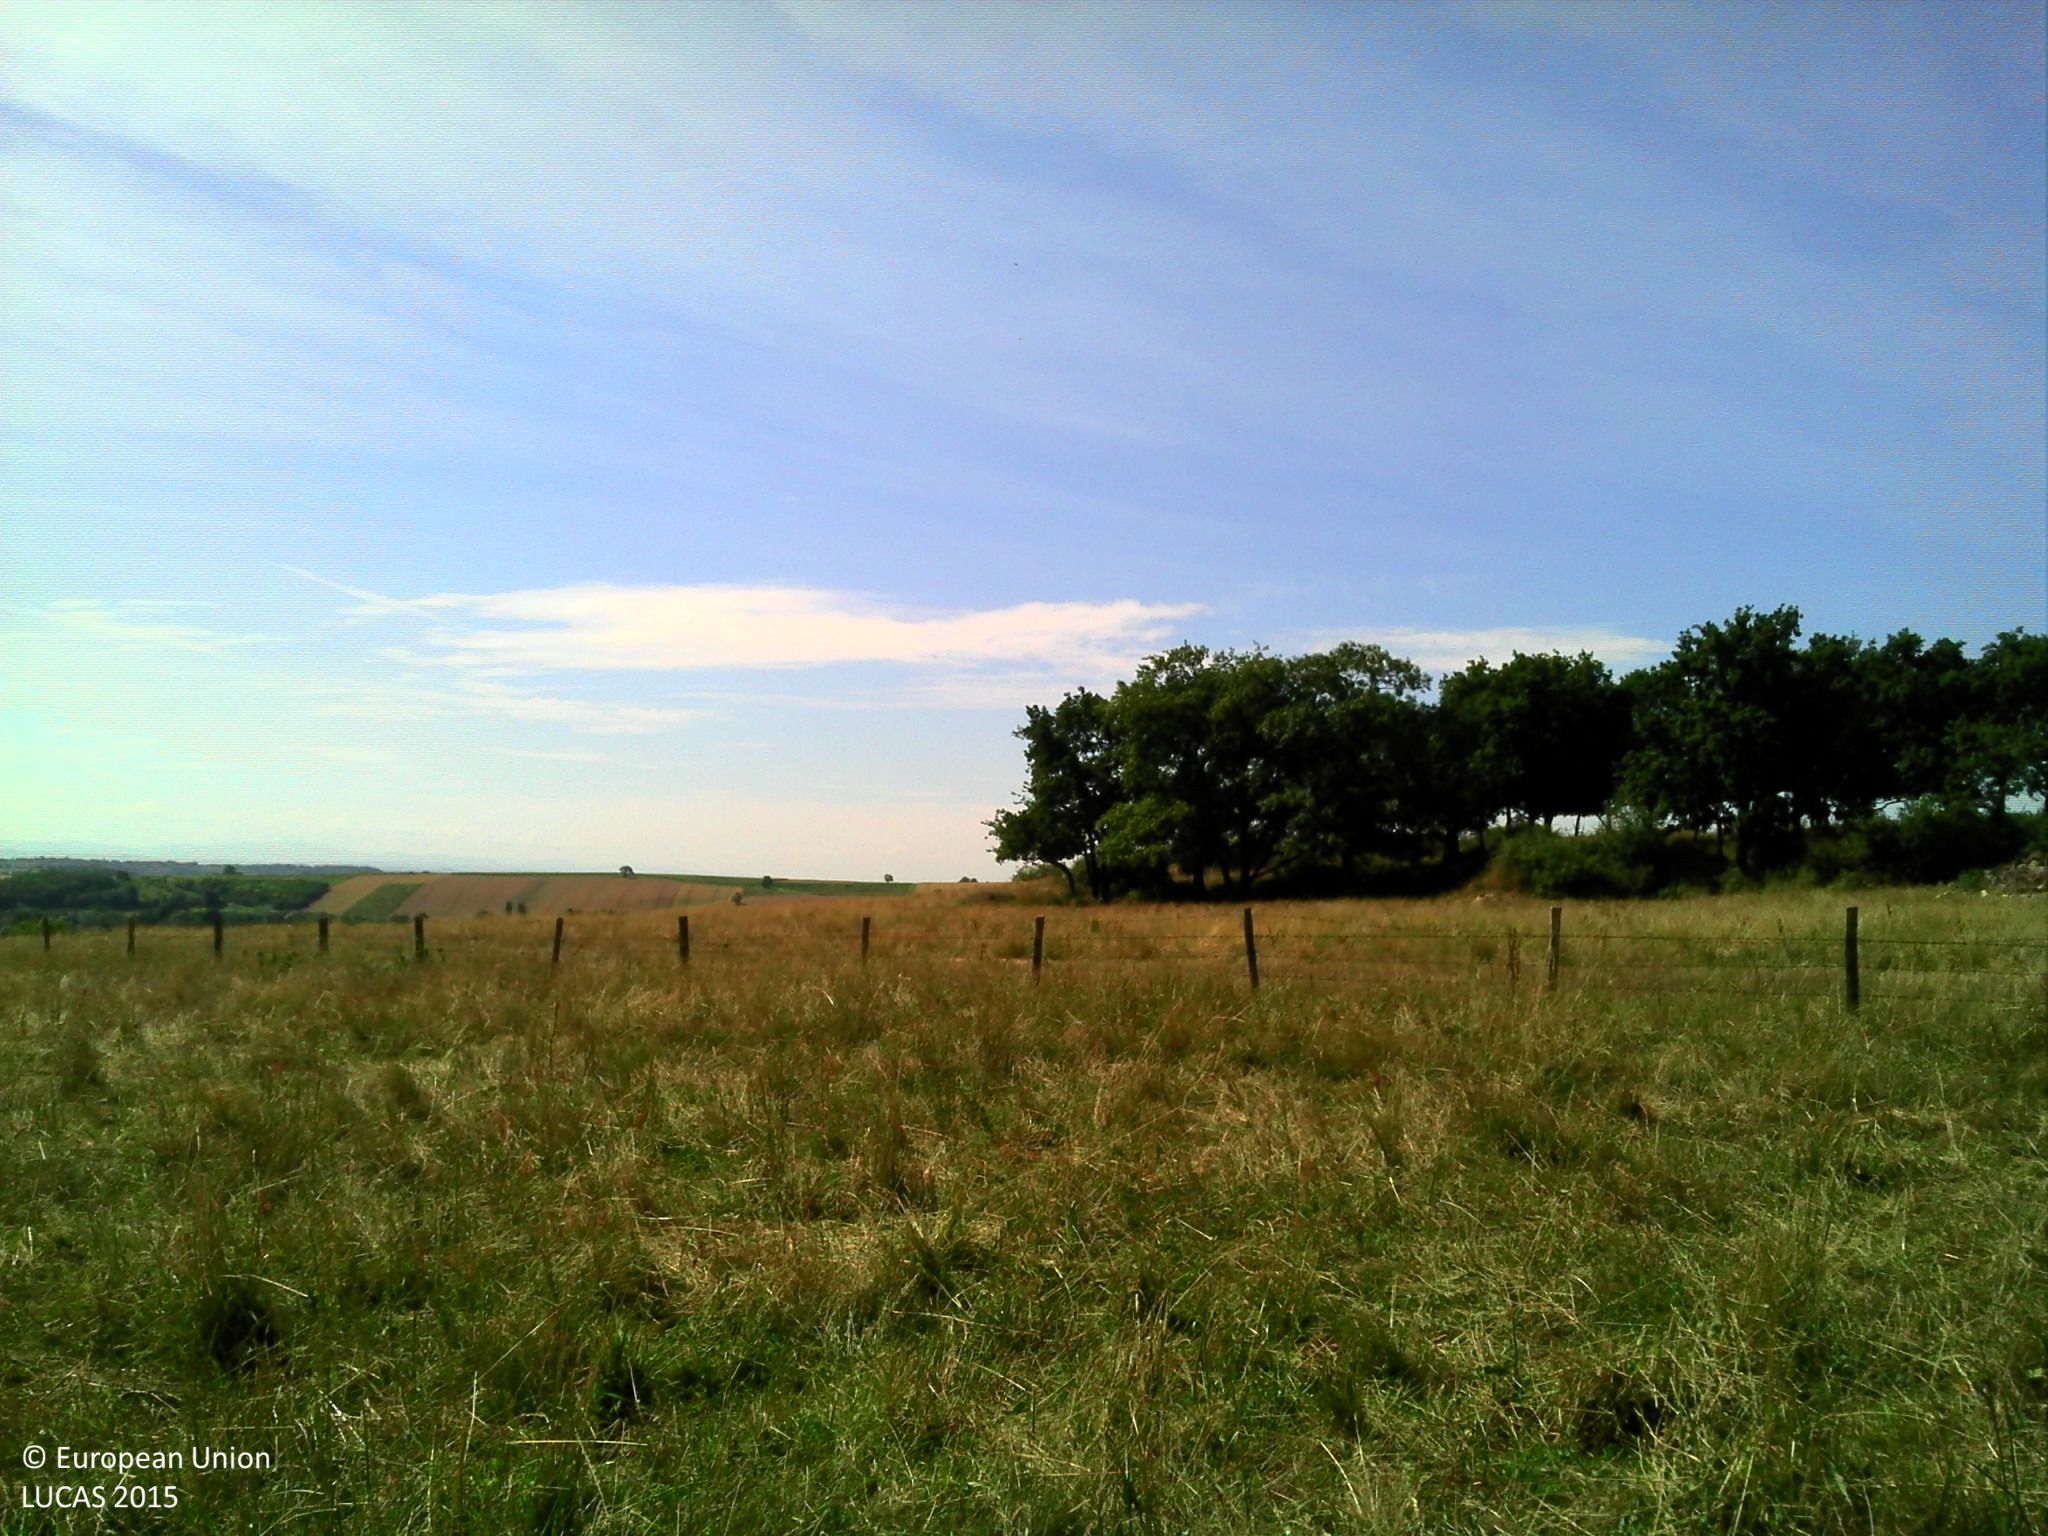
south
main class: Grassland
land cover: Grassland without tree/shrub cover
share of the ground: > 75 %
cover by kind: herbaceous plants 100 %
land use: Agriculture (excluding fallow land and kitchen gardens)
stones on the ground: < 10 %
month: June
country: FR
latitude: 46.3550
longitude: 3.2537
